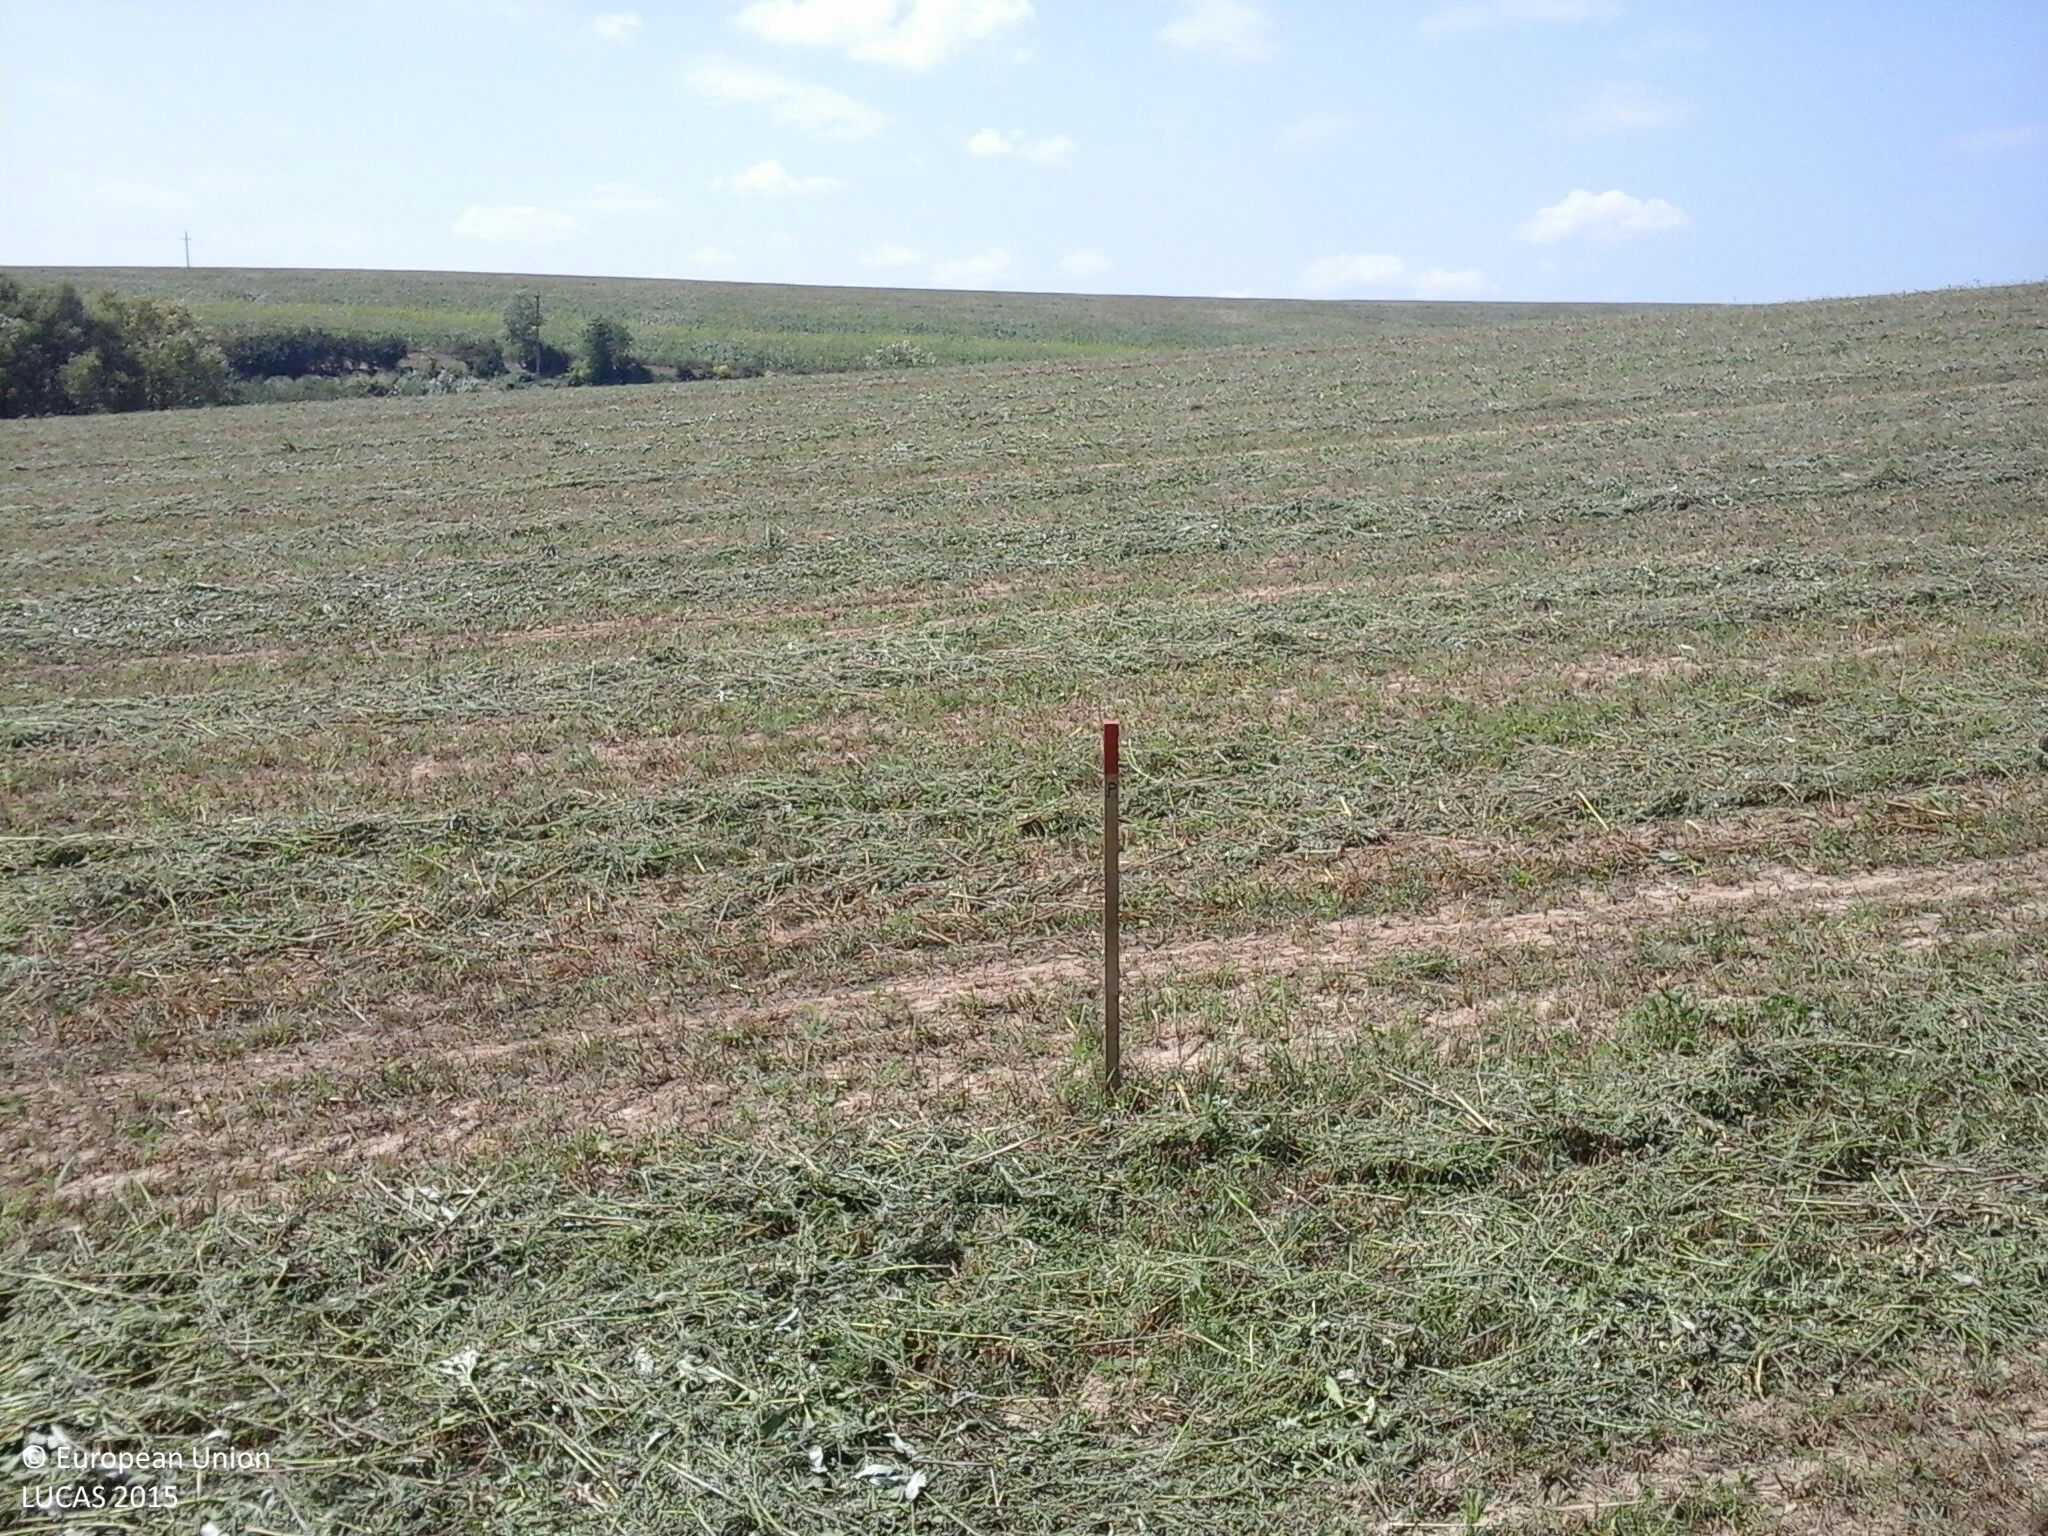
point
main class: Cropland
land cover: Lucerne
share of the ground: 25 - 50 %
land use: Agriculture (excluding fallow land and kitchen gardens)
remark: Harvested field
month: August
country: HU
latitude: 46.7206
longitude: 18.0020
